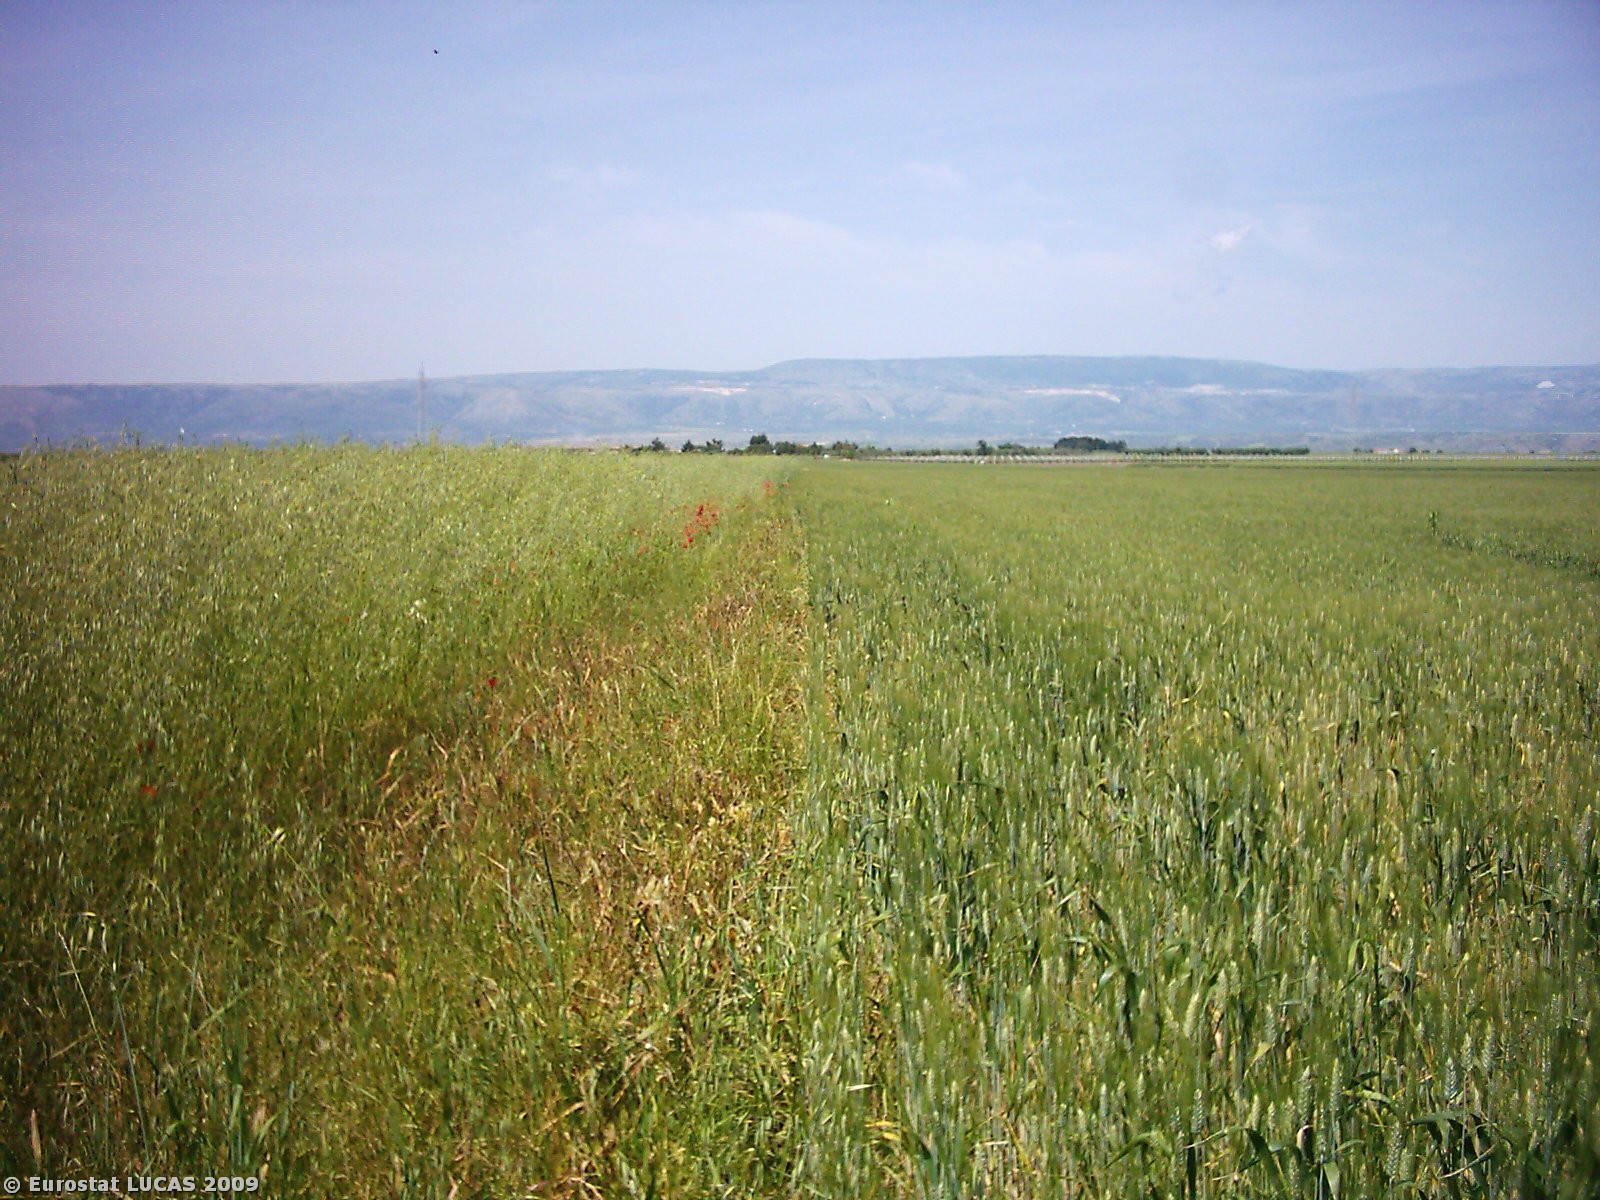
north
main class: Cropland
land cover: Oats
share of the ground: > 75 %
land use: Agriculture (excluding fallow land and kitchen gardens)
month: May
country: IT
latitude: 41.5545
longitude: 15.6532
